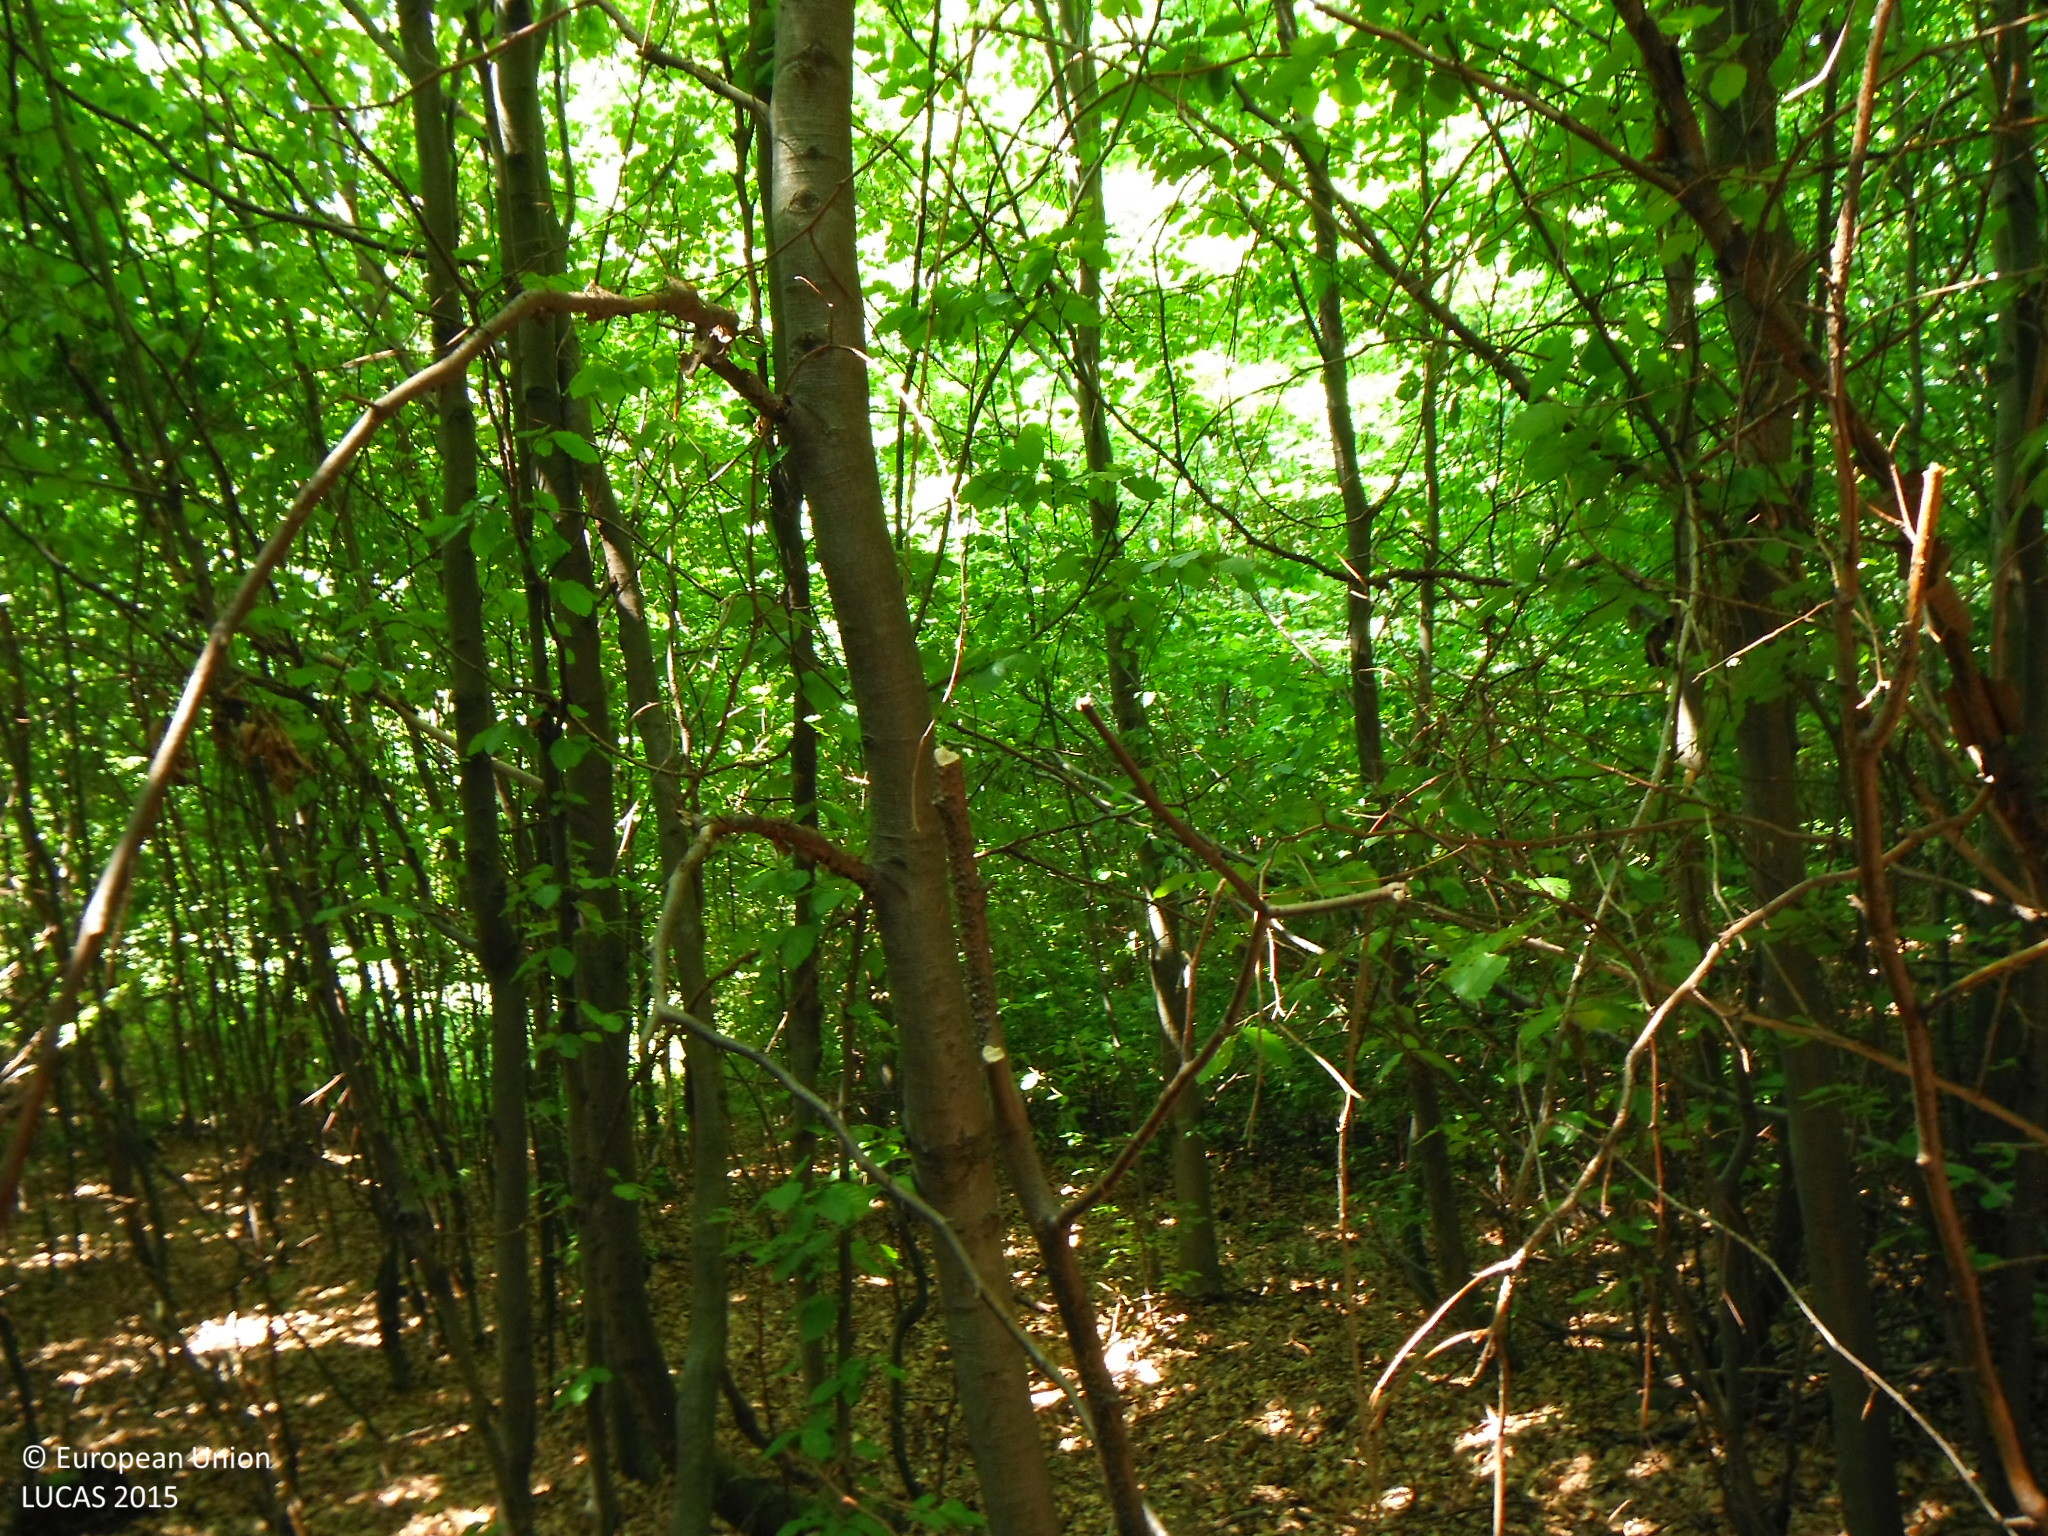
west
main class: Woodland
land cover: Broadleaved woodland
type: beech forest
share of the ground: > 75 %
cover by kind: broadleaved forest trees 100 %
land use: Forestry
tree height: > 5 m
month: July
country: SK
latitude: 49.3526
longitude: 21.4332
